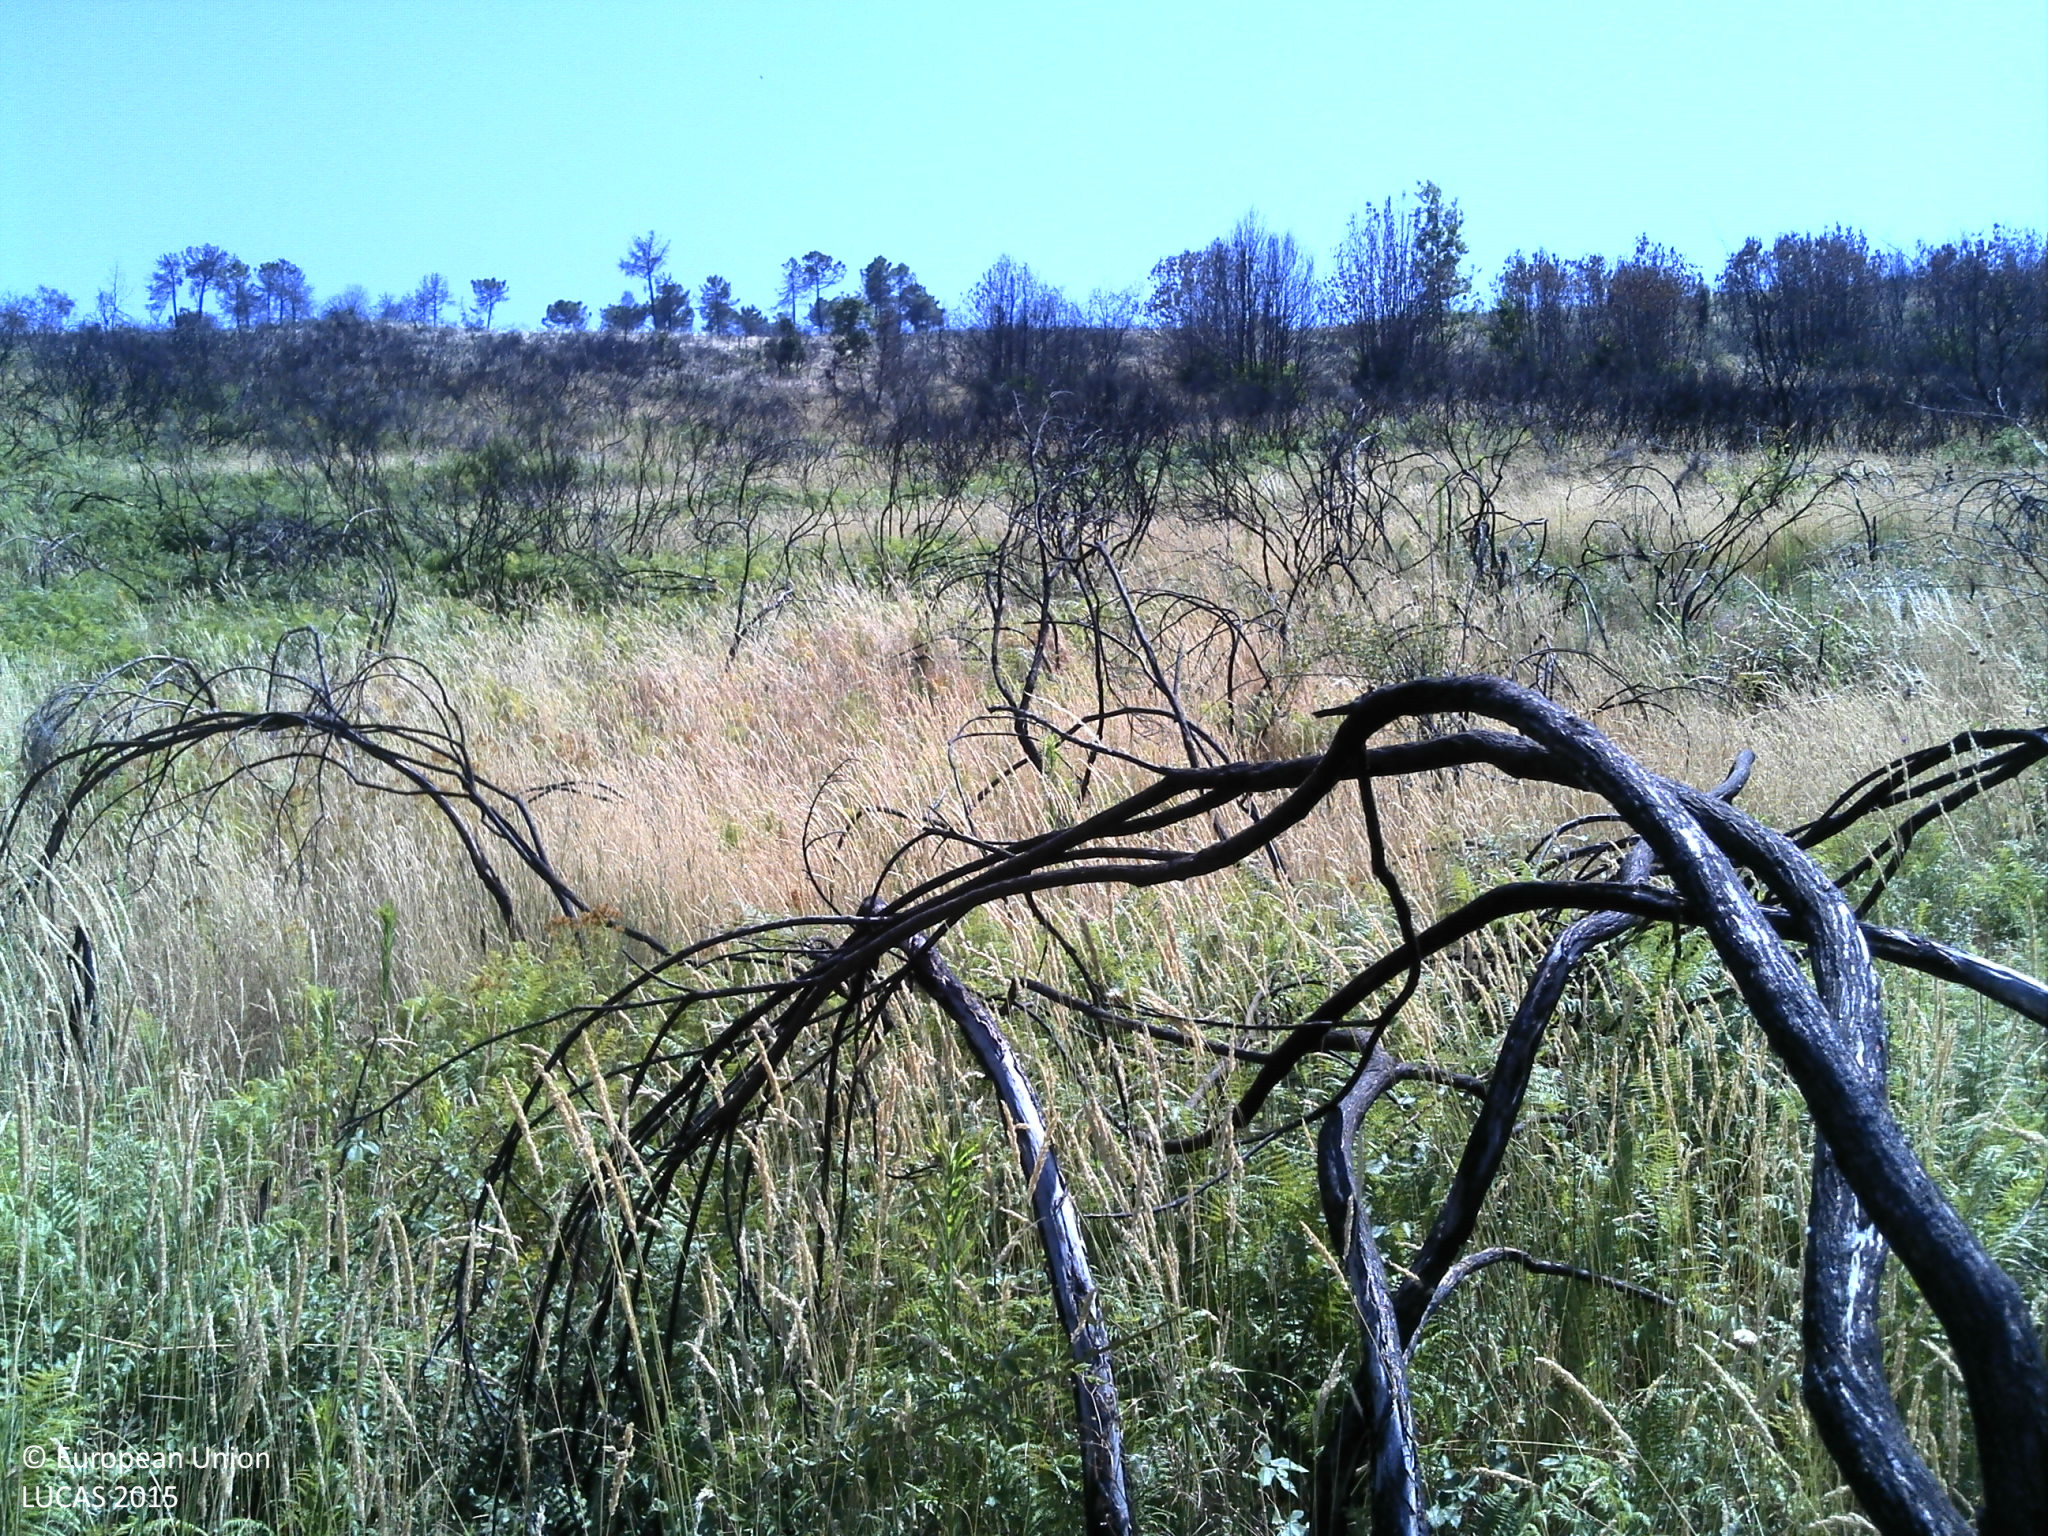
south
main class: Shrubland
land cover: Shrubland without tree cover
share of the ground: > 75 %
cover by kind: shrubs 100 %
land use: Semi-natural and natural areas not in use
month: July
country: PT
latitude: 41.0458
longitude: -7.3791
